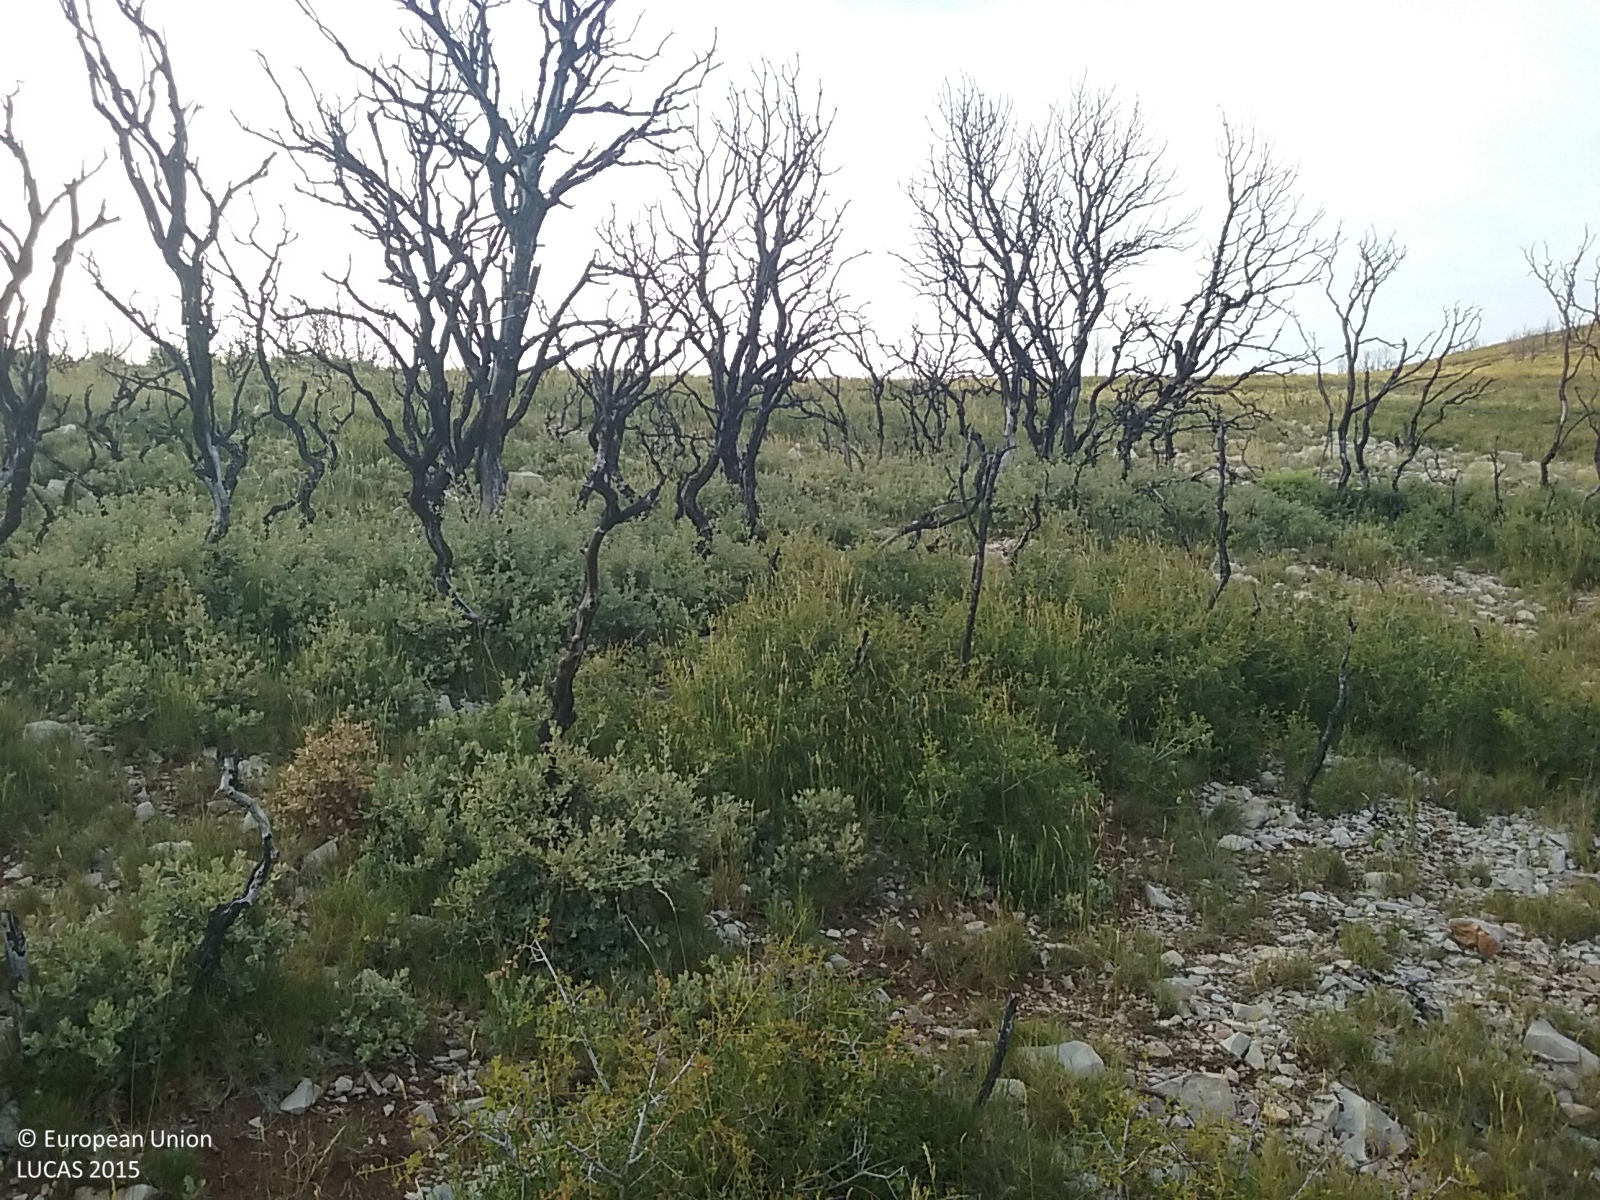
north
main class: Shrubland
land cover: Shrubland without tree cover
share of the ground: 50 - 75 %
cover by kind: shrubs 60 %, herbaceous plants 30 %, unconsolidated bare surface 10 %
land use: Semi-natural and natural areas not in use
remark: Burnt area
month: July
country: ES
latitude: 39.8680
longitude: -0.6531
